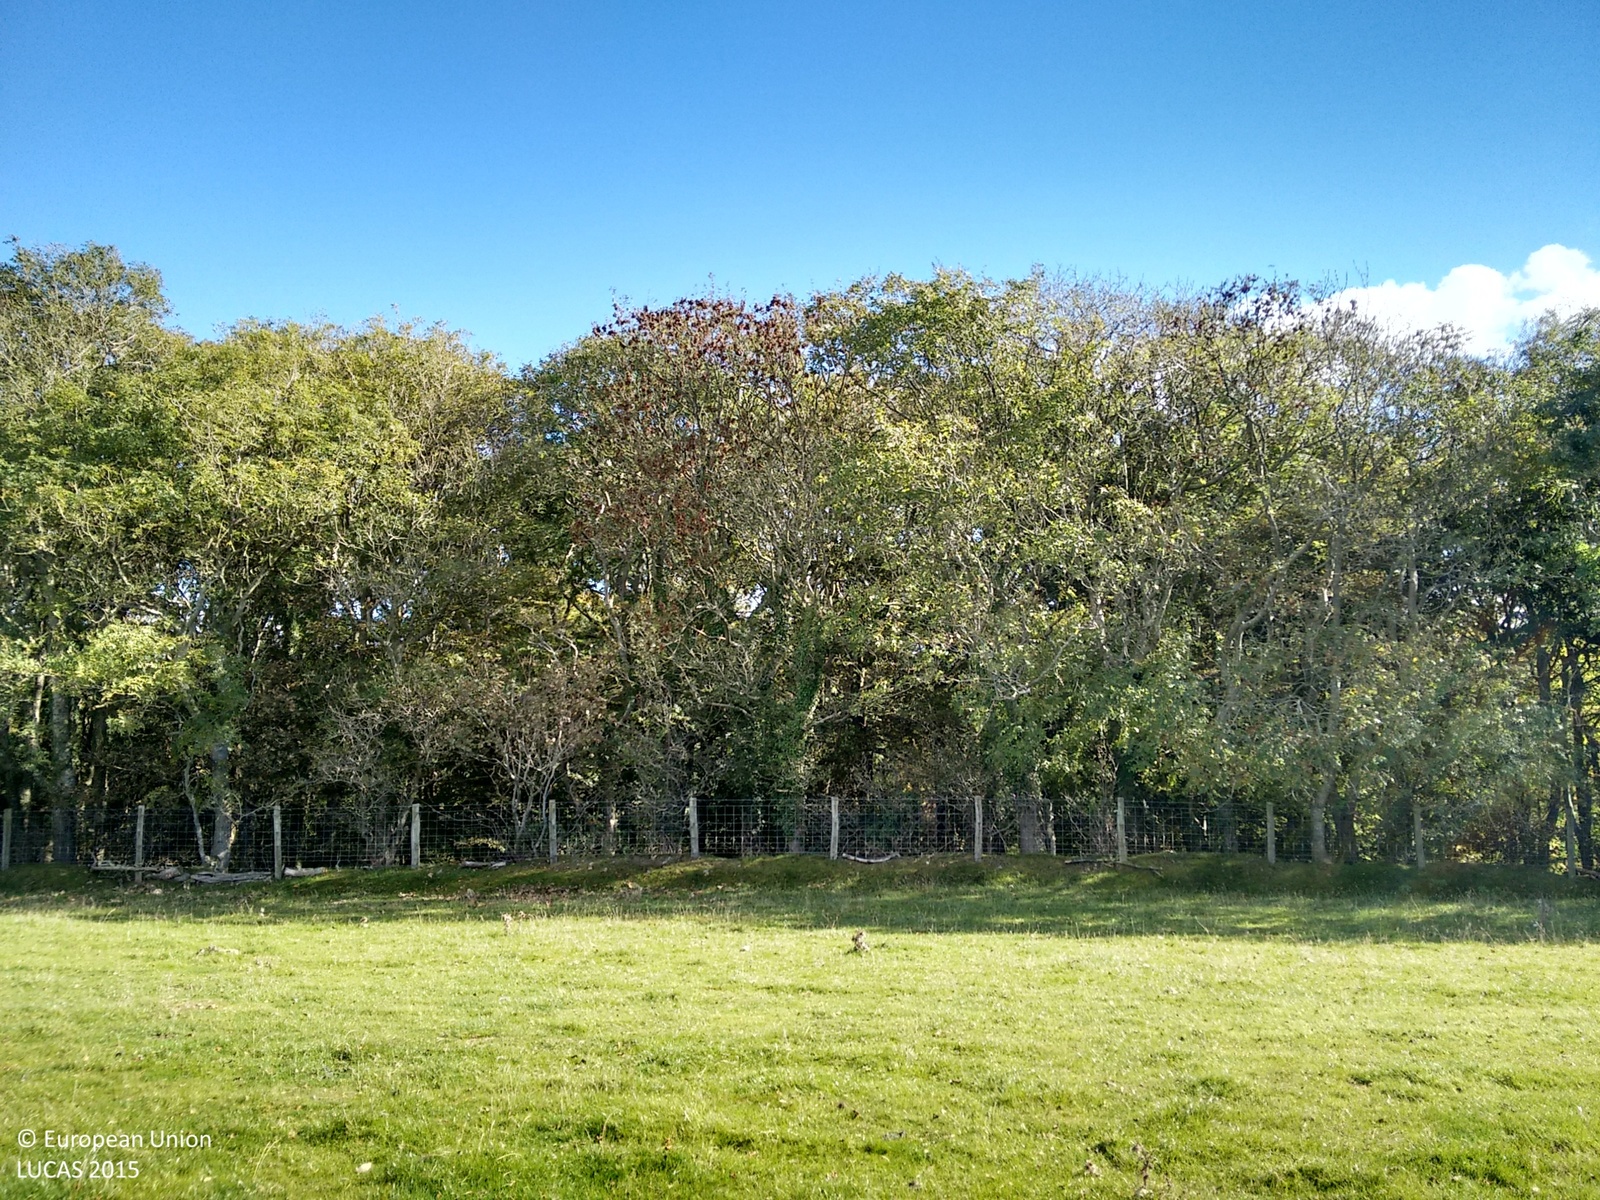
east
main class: Grassland
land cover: Grassland without tree/shrub cover
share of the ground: > 75 %
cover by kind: herbaceous plants 100 %
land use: Agriculture (excluding fallow land and kitchen gardens)
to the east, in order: Grassland without tree/shrub cover; Fences; Broadleaved woodland; Tracks; Grass margins; Managed hedges; Fences; Grassland without tree/shrub cover; Electric lines; Grassland without tree/shrub cover; Broadleaved woodland; Rivers and streams; Broadleaved woodland; Grassland without tree/shrub cover
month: October
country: GB
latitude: 52.3324
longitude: -4.1115
